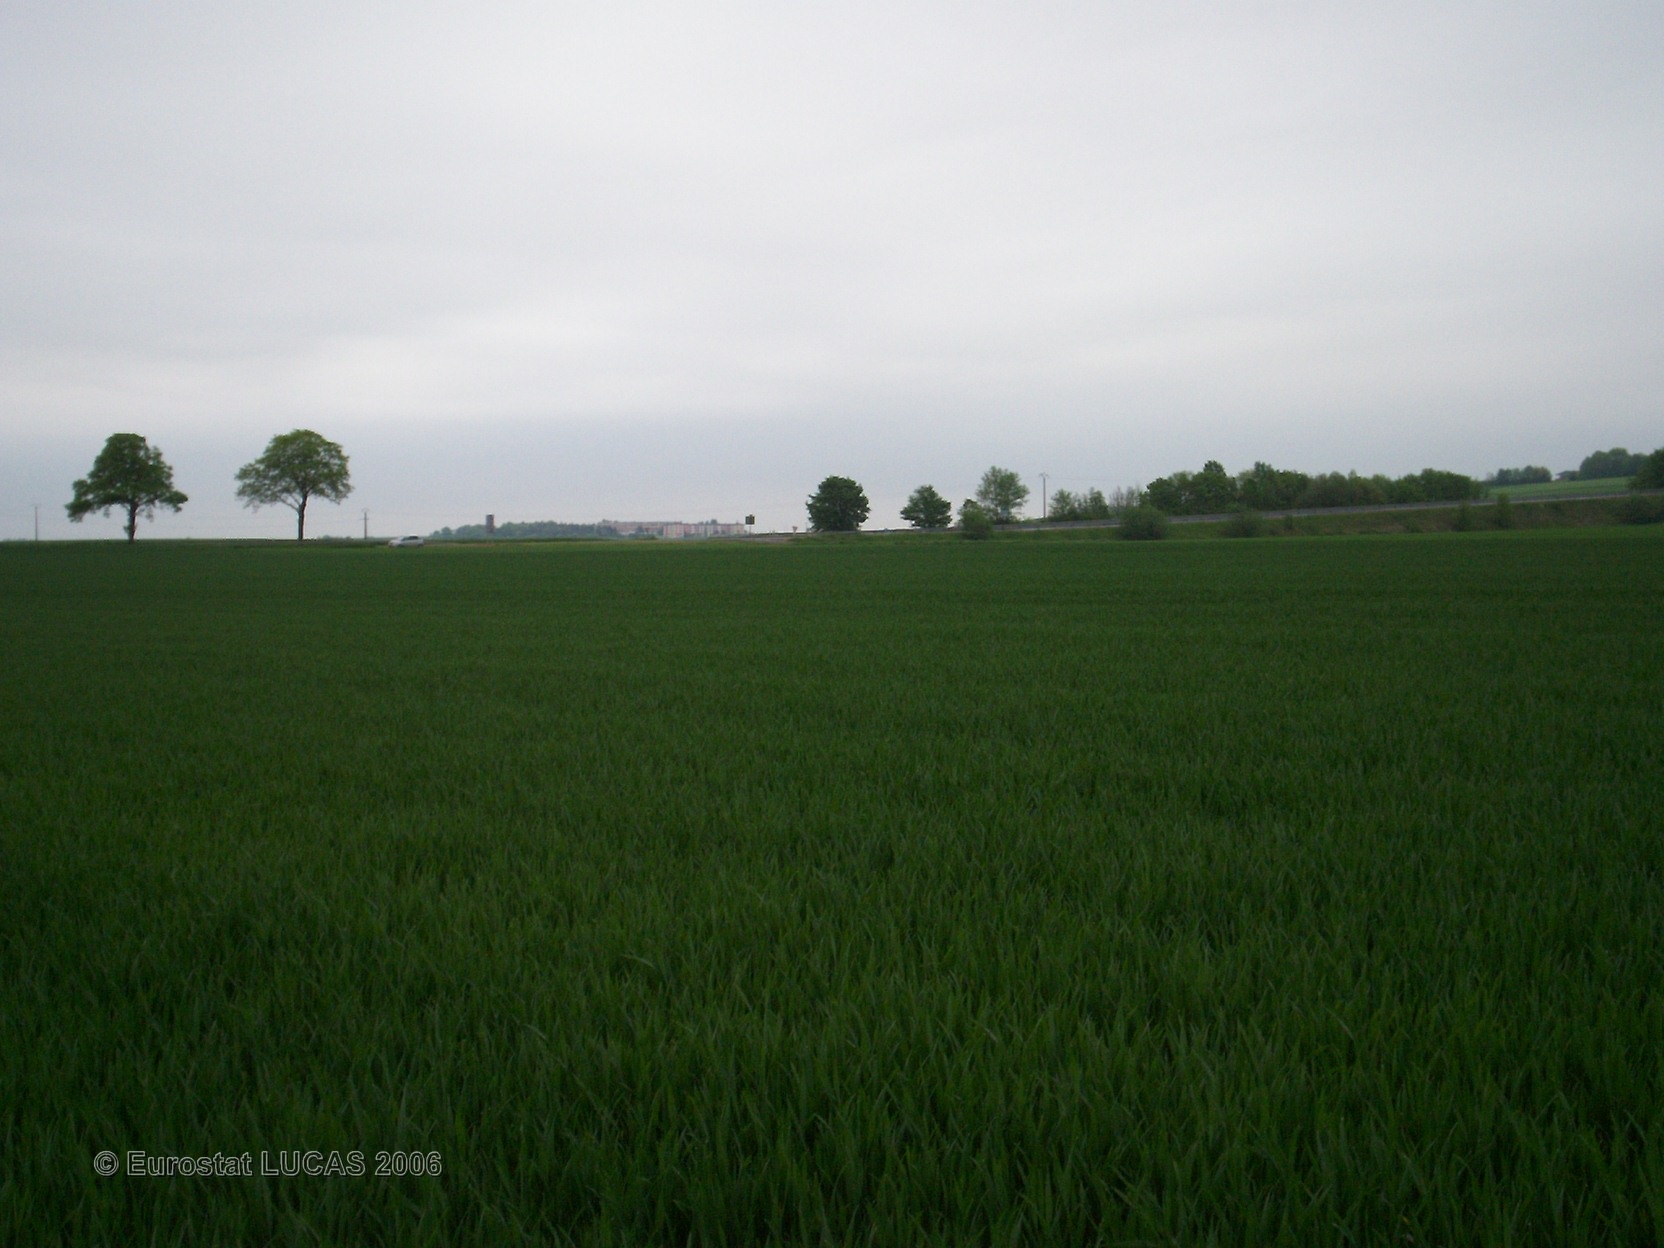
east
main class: Cropland
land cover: Common wheat
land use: Agriculture (excluding fallow land and kitchen gardens)
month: May
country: FR
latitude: 49.5212
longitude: 4.3459
